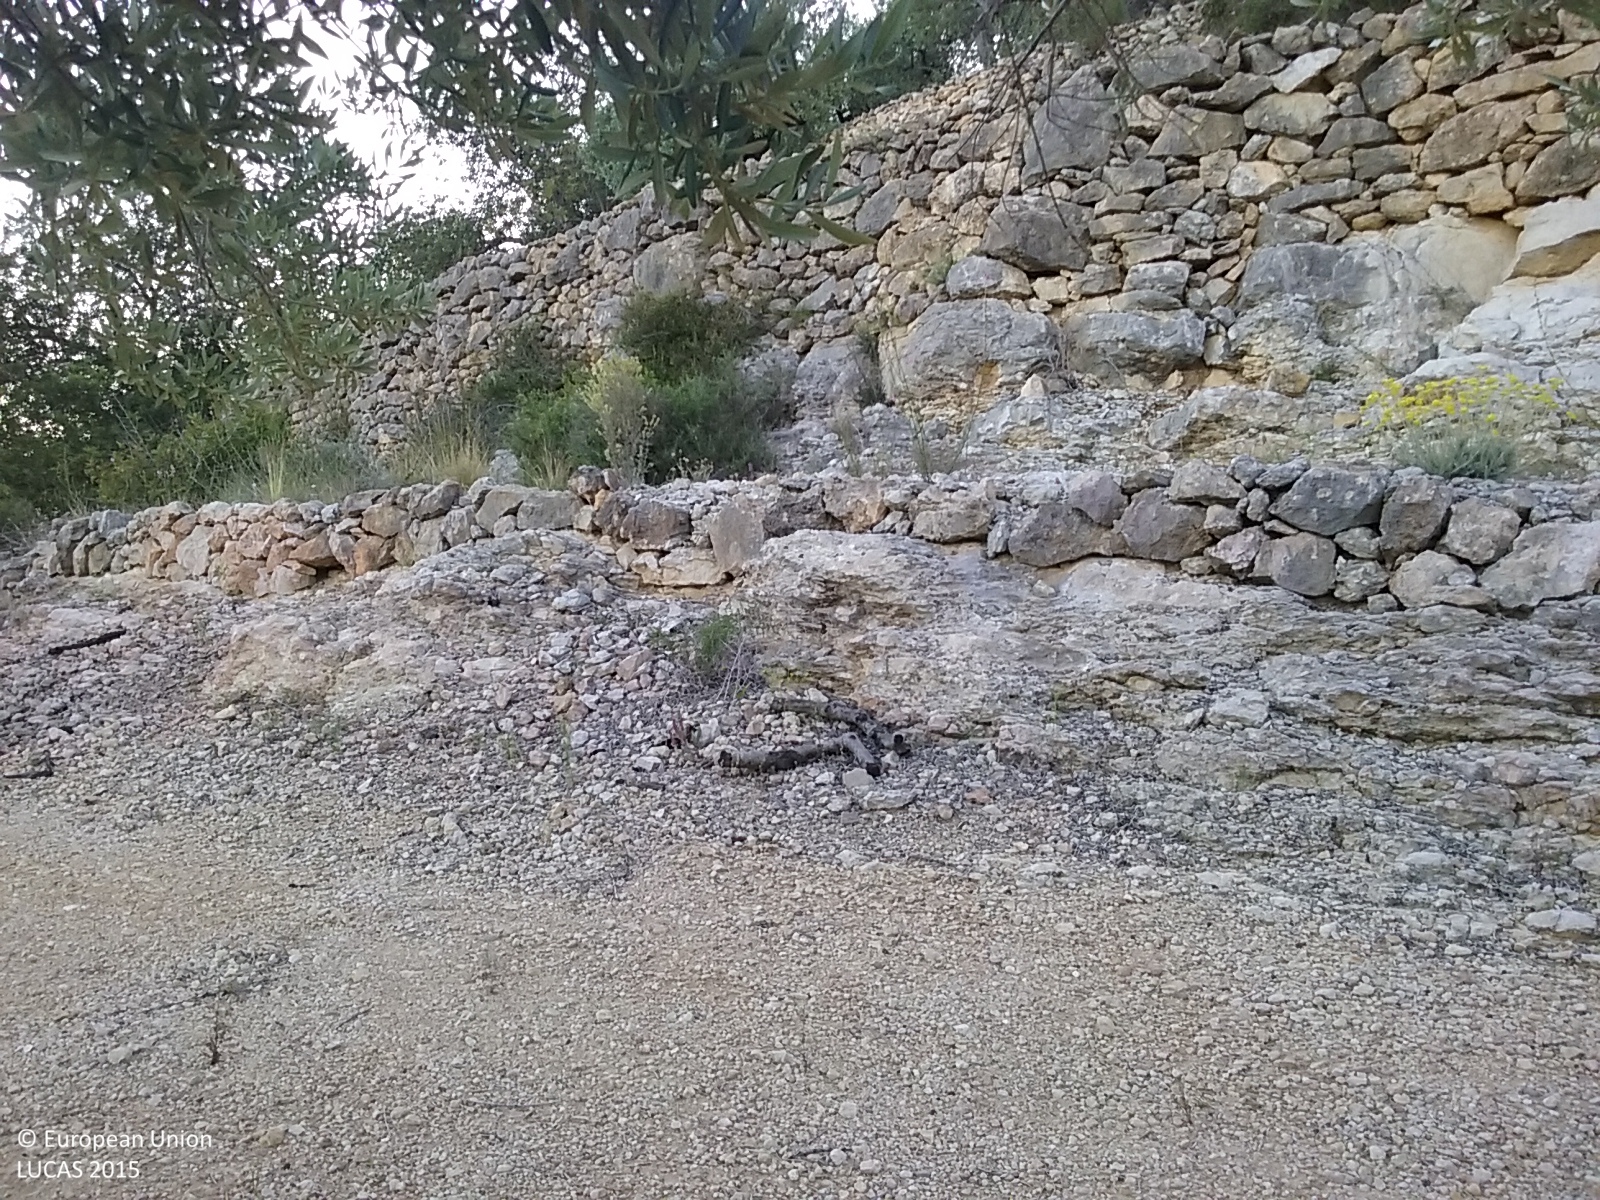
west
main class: Cropland
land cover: Olive groves
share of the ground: 25 - 50 %
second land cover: Spontaneously vegetated surfaces
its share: 10 - 25 %
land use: Agriculture (excluding fallow land and kitchen gardens)
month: May
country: ES
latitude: 40.7929
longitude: 0.5485
